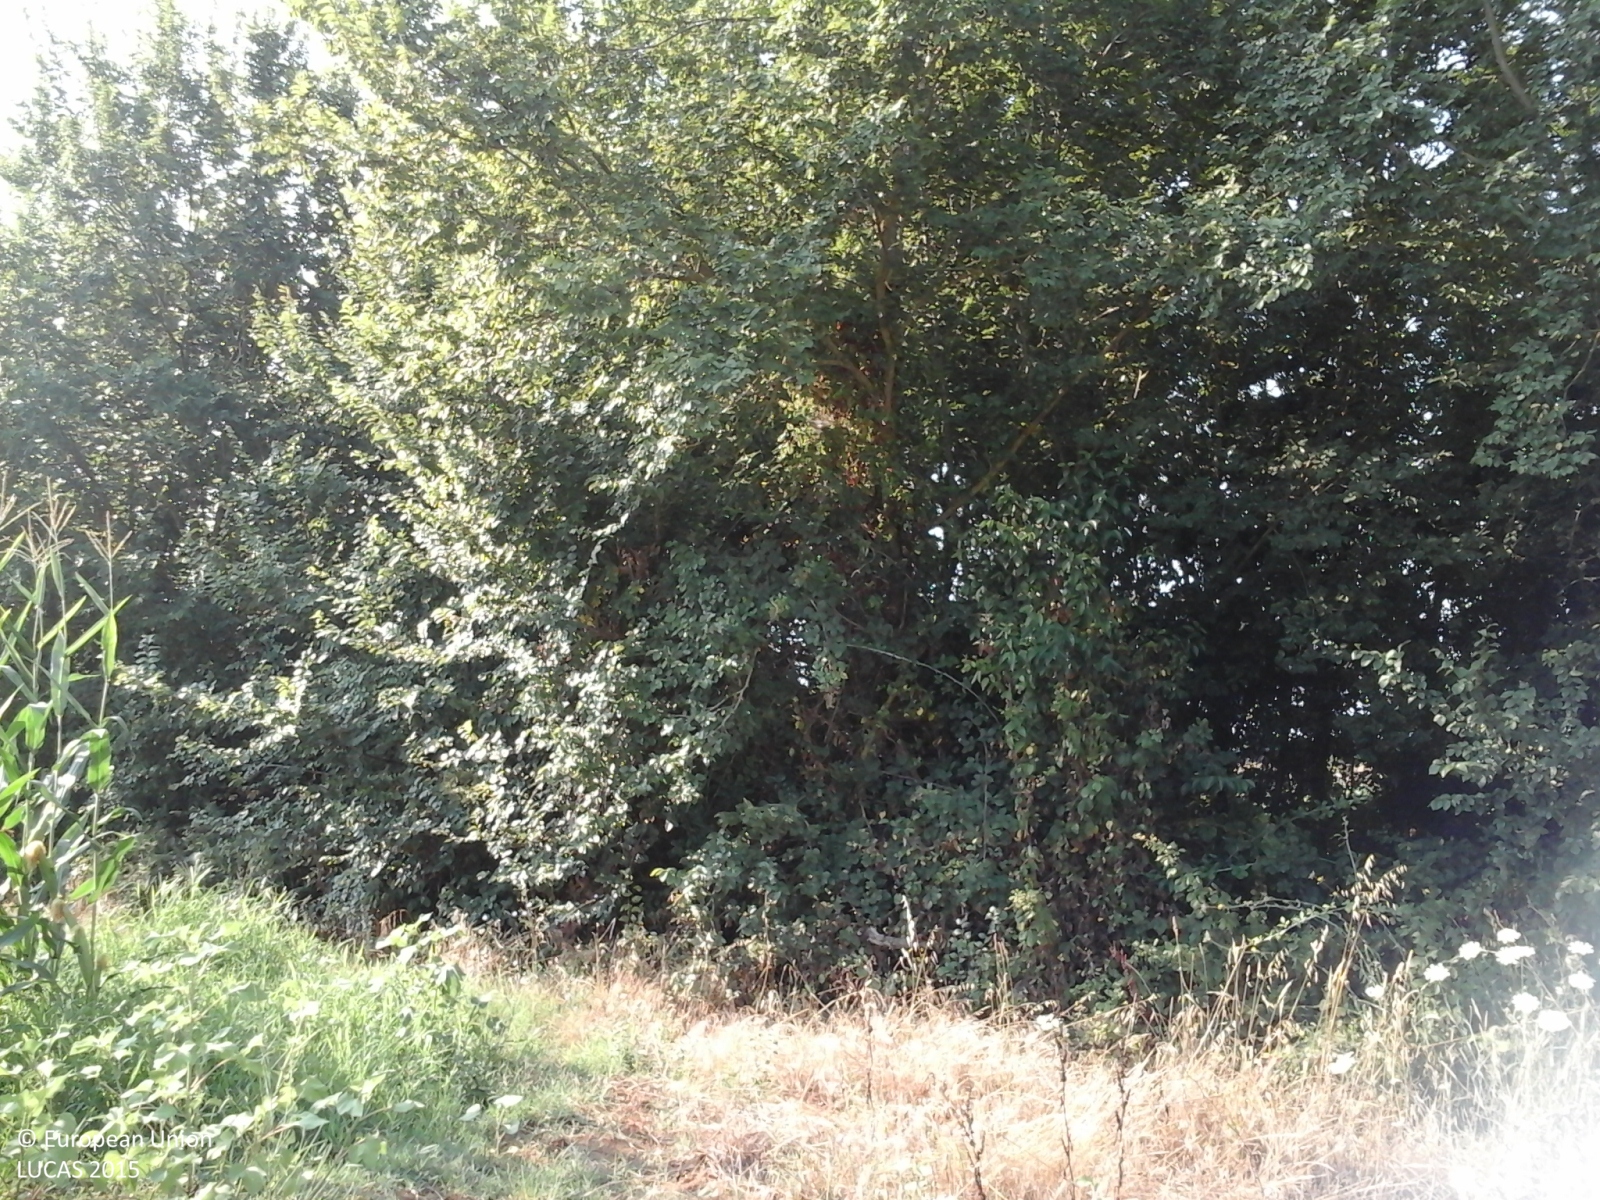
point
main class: Woodland
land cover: Broadleaved woodland
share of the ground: > 75 %
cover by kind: broadleaved forest trees 95 %, herbaceous plants 5 %
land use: Semi-natural and natural areas not in use
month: July
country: IT
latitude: 41.4193
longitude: 12.8957
